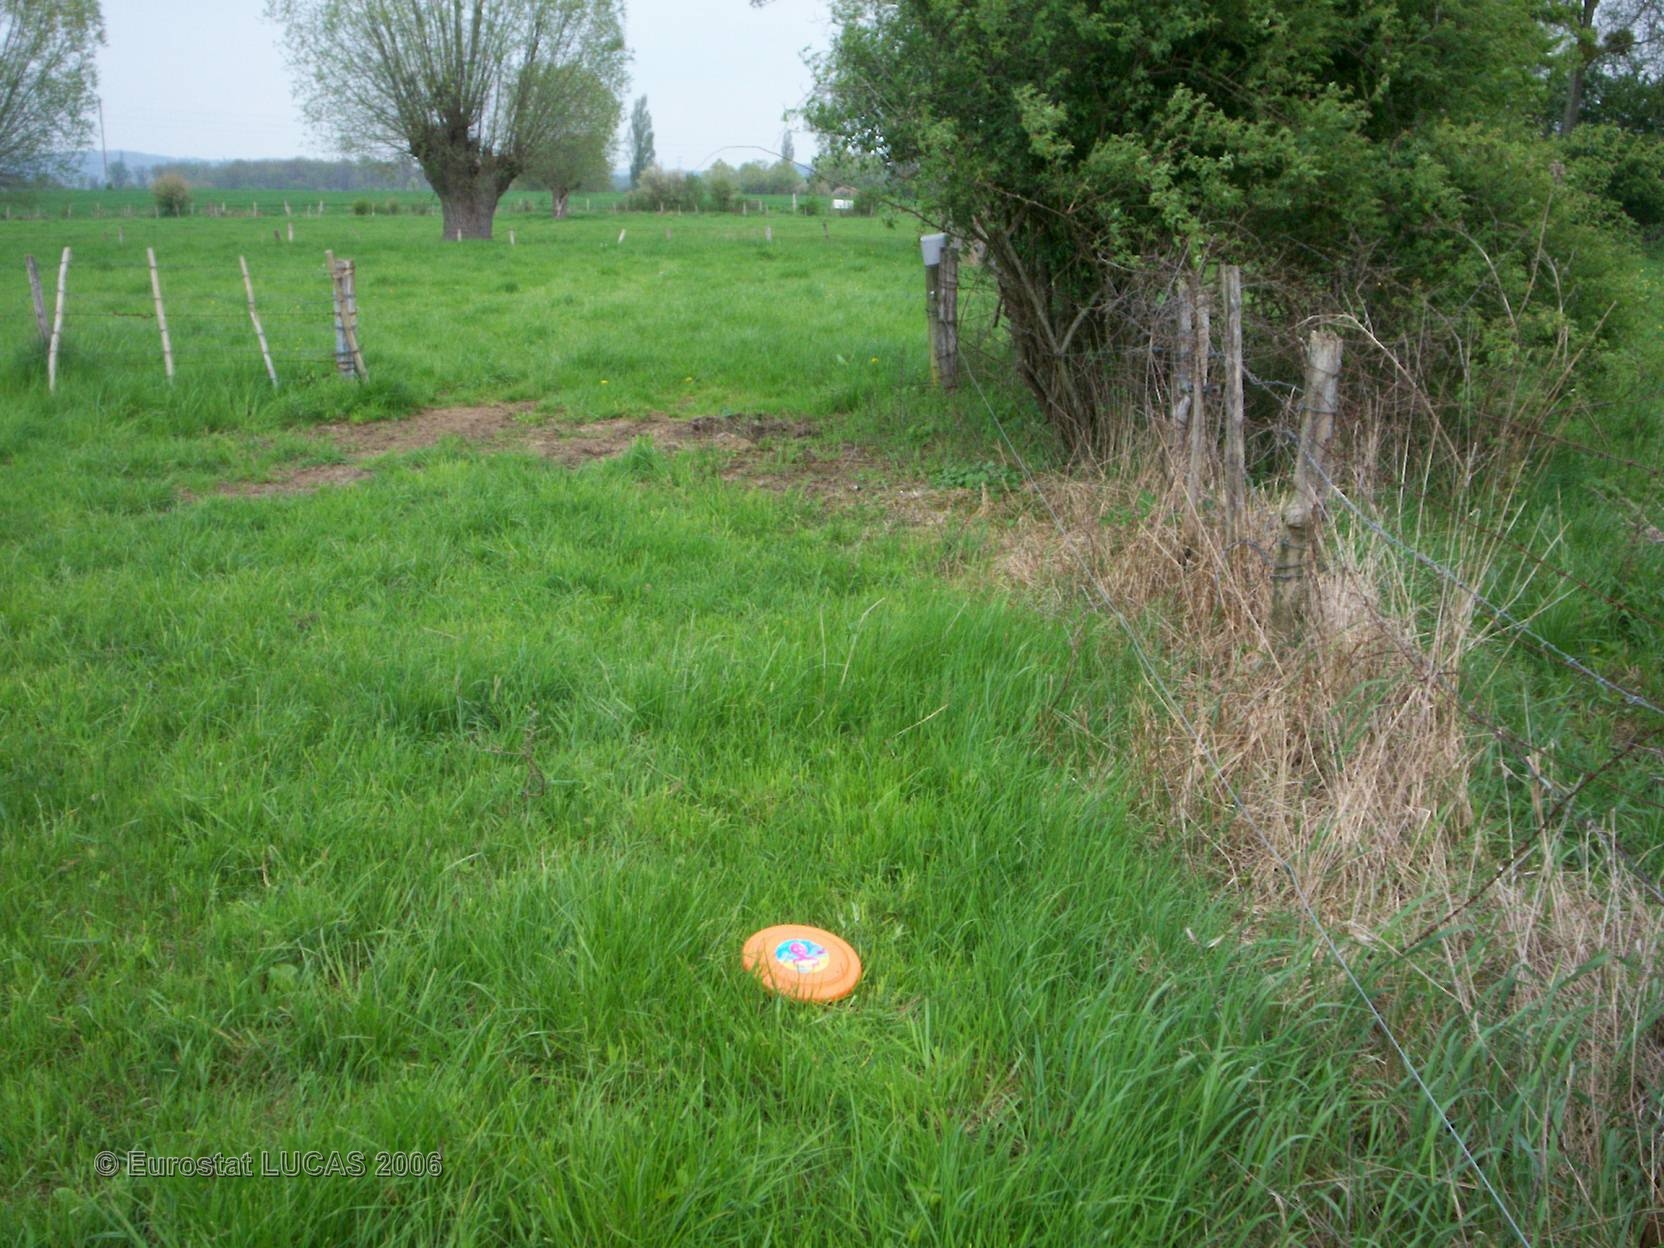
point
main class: Grassland
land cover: Grassland with sparse tree/shrub cover
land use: Agriculture (excluding fallow land and kitchen gardens)
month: April
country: FR
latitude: 47.0831
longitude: 3.0542
